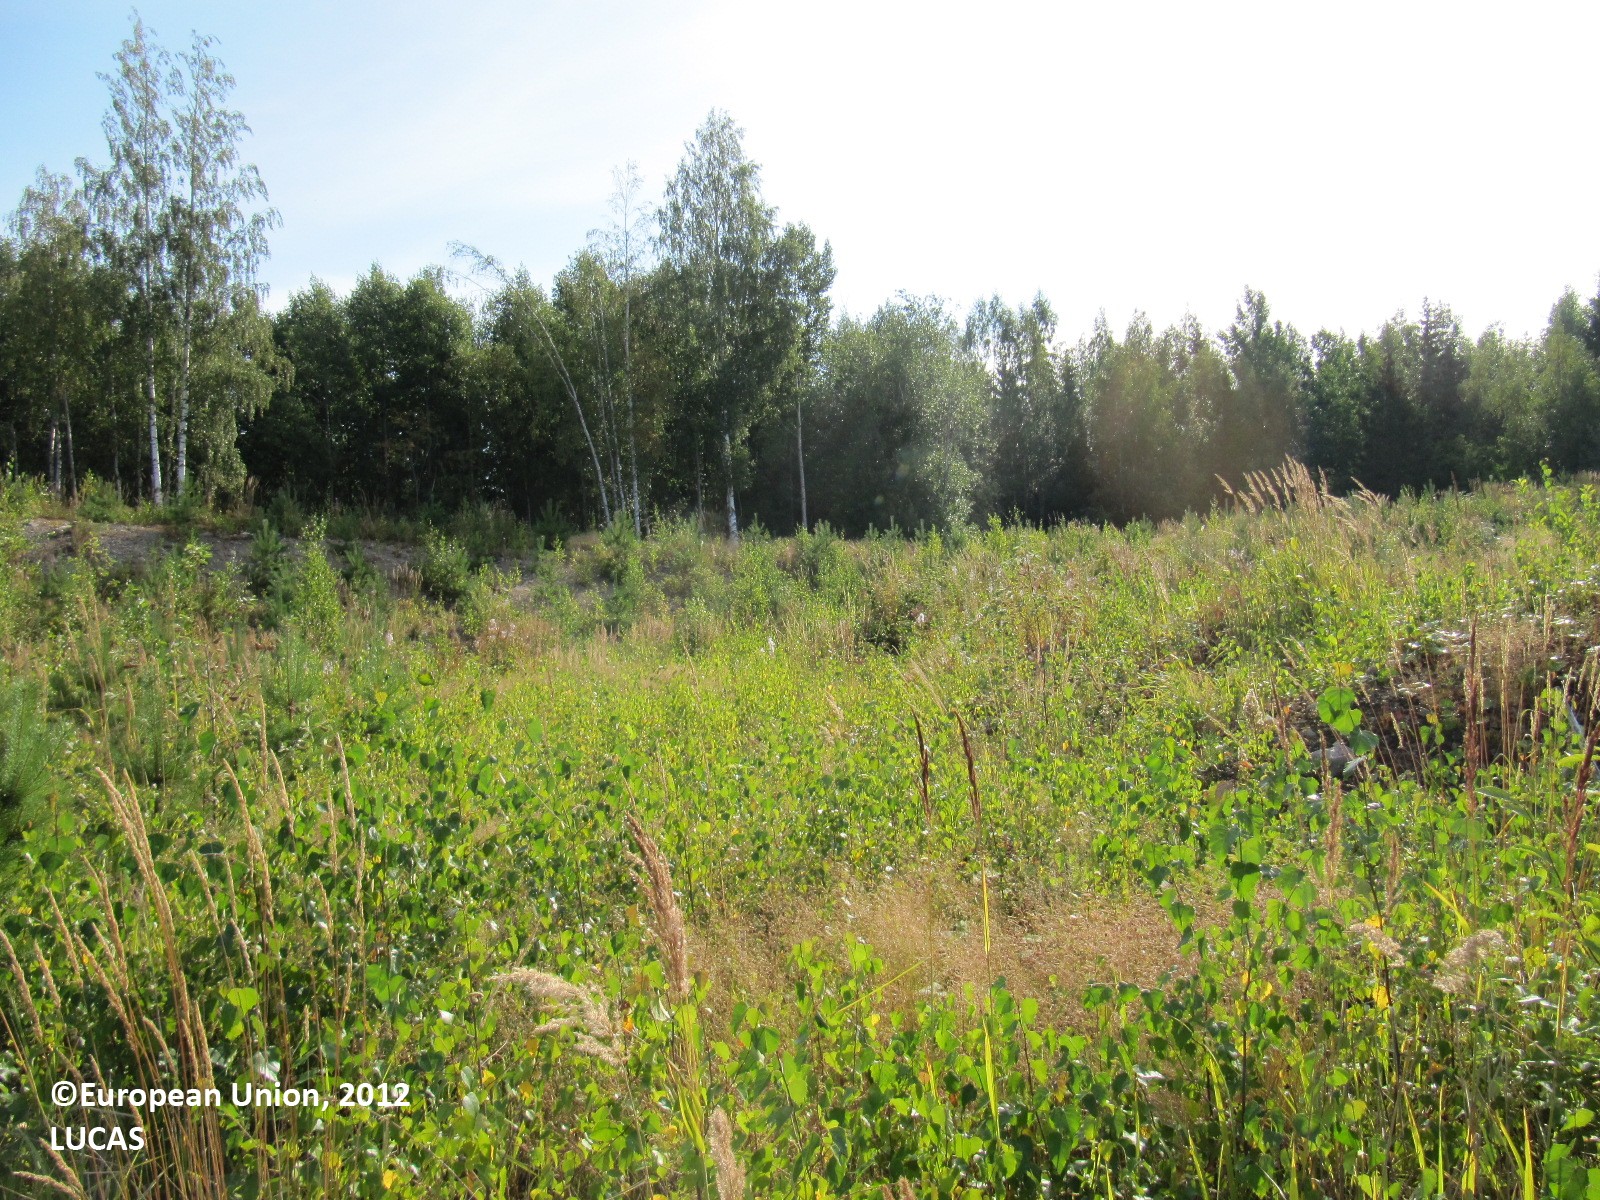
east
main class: Woodland
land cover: Other mixed woodland
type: boreal forest
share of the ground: > 75 %
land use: Mining and quarrying
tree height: < 5 m
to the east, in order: Other mixed woodland; Broadleaved woodland; Paved roads, cycling and walking lanes; Spruce dominated coniferous woodland; Other mixed woodland
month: August
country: FI
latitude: 60.5148
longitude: 24.4392
